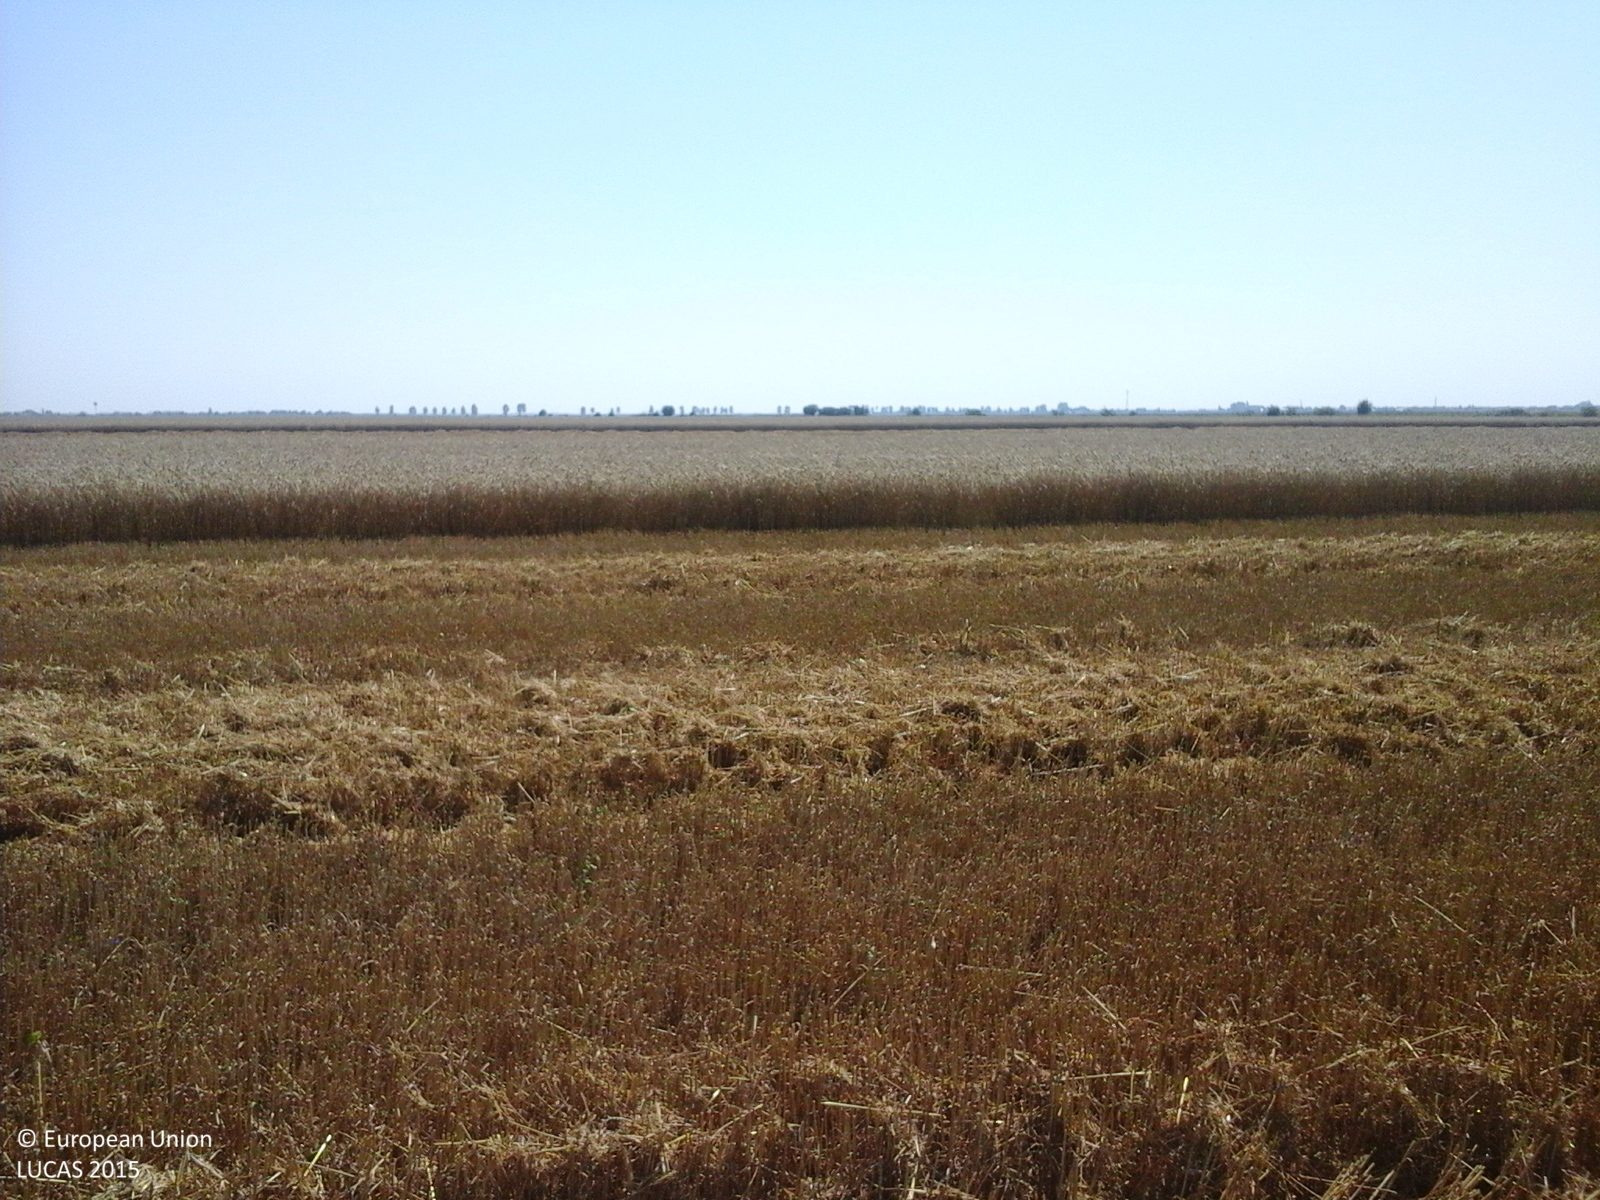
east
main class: Cropland
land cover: Common wheat
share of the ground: < 10 %
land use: Agriculture (excluding fallow land and kitchen gardens)
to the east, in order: Common wheat
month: July
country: RO
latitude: 44.1307
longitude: 24.6308
